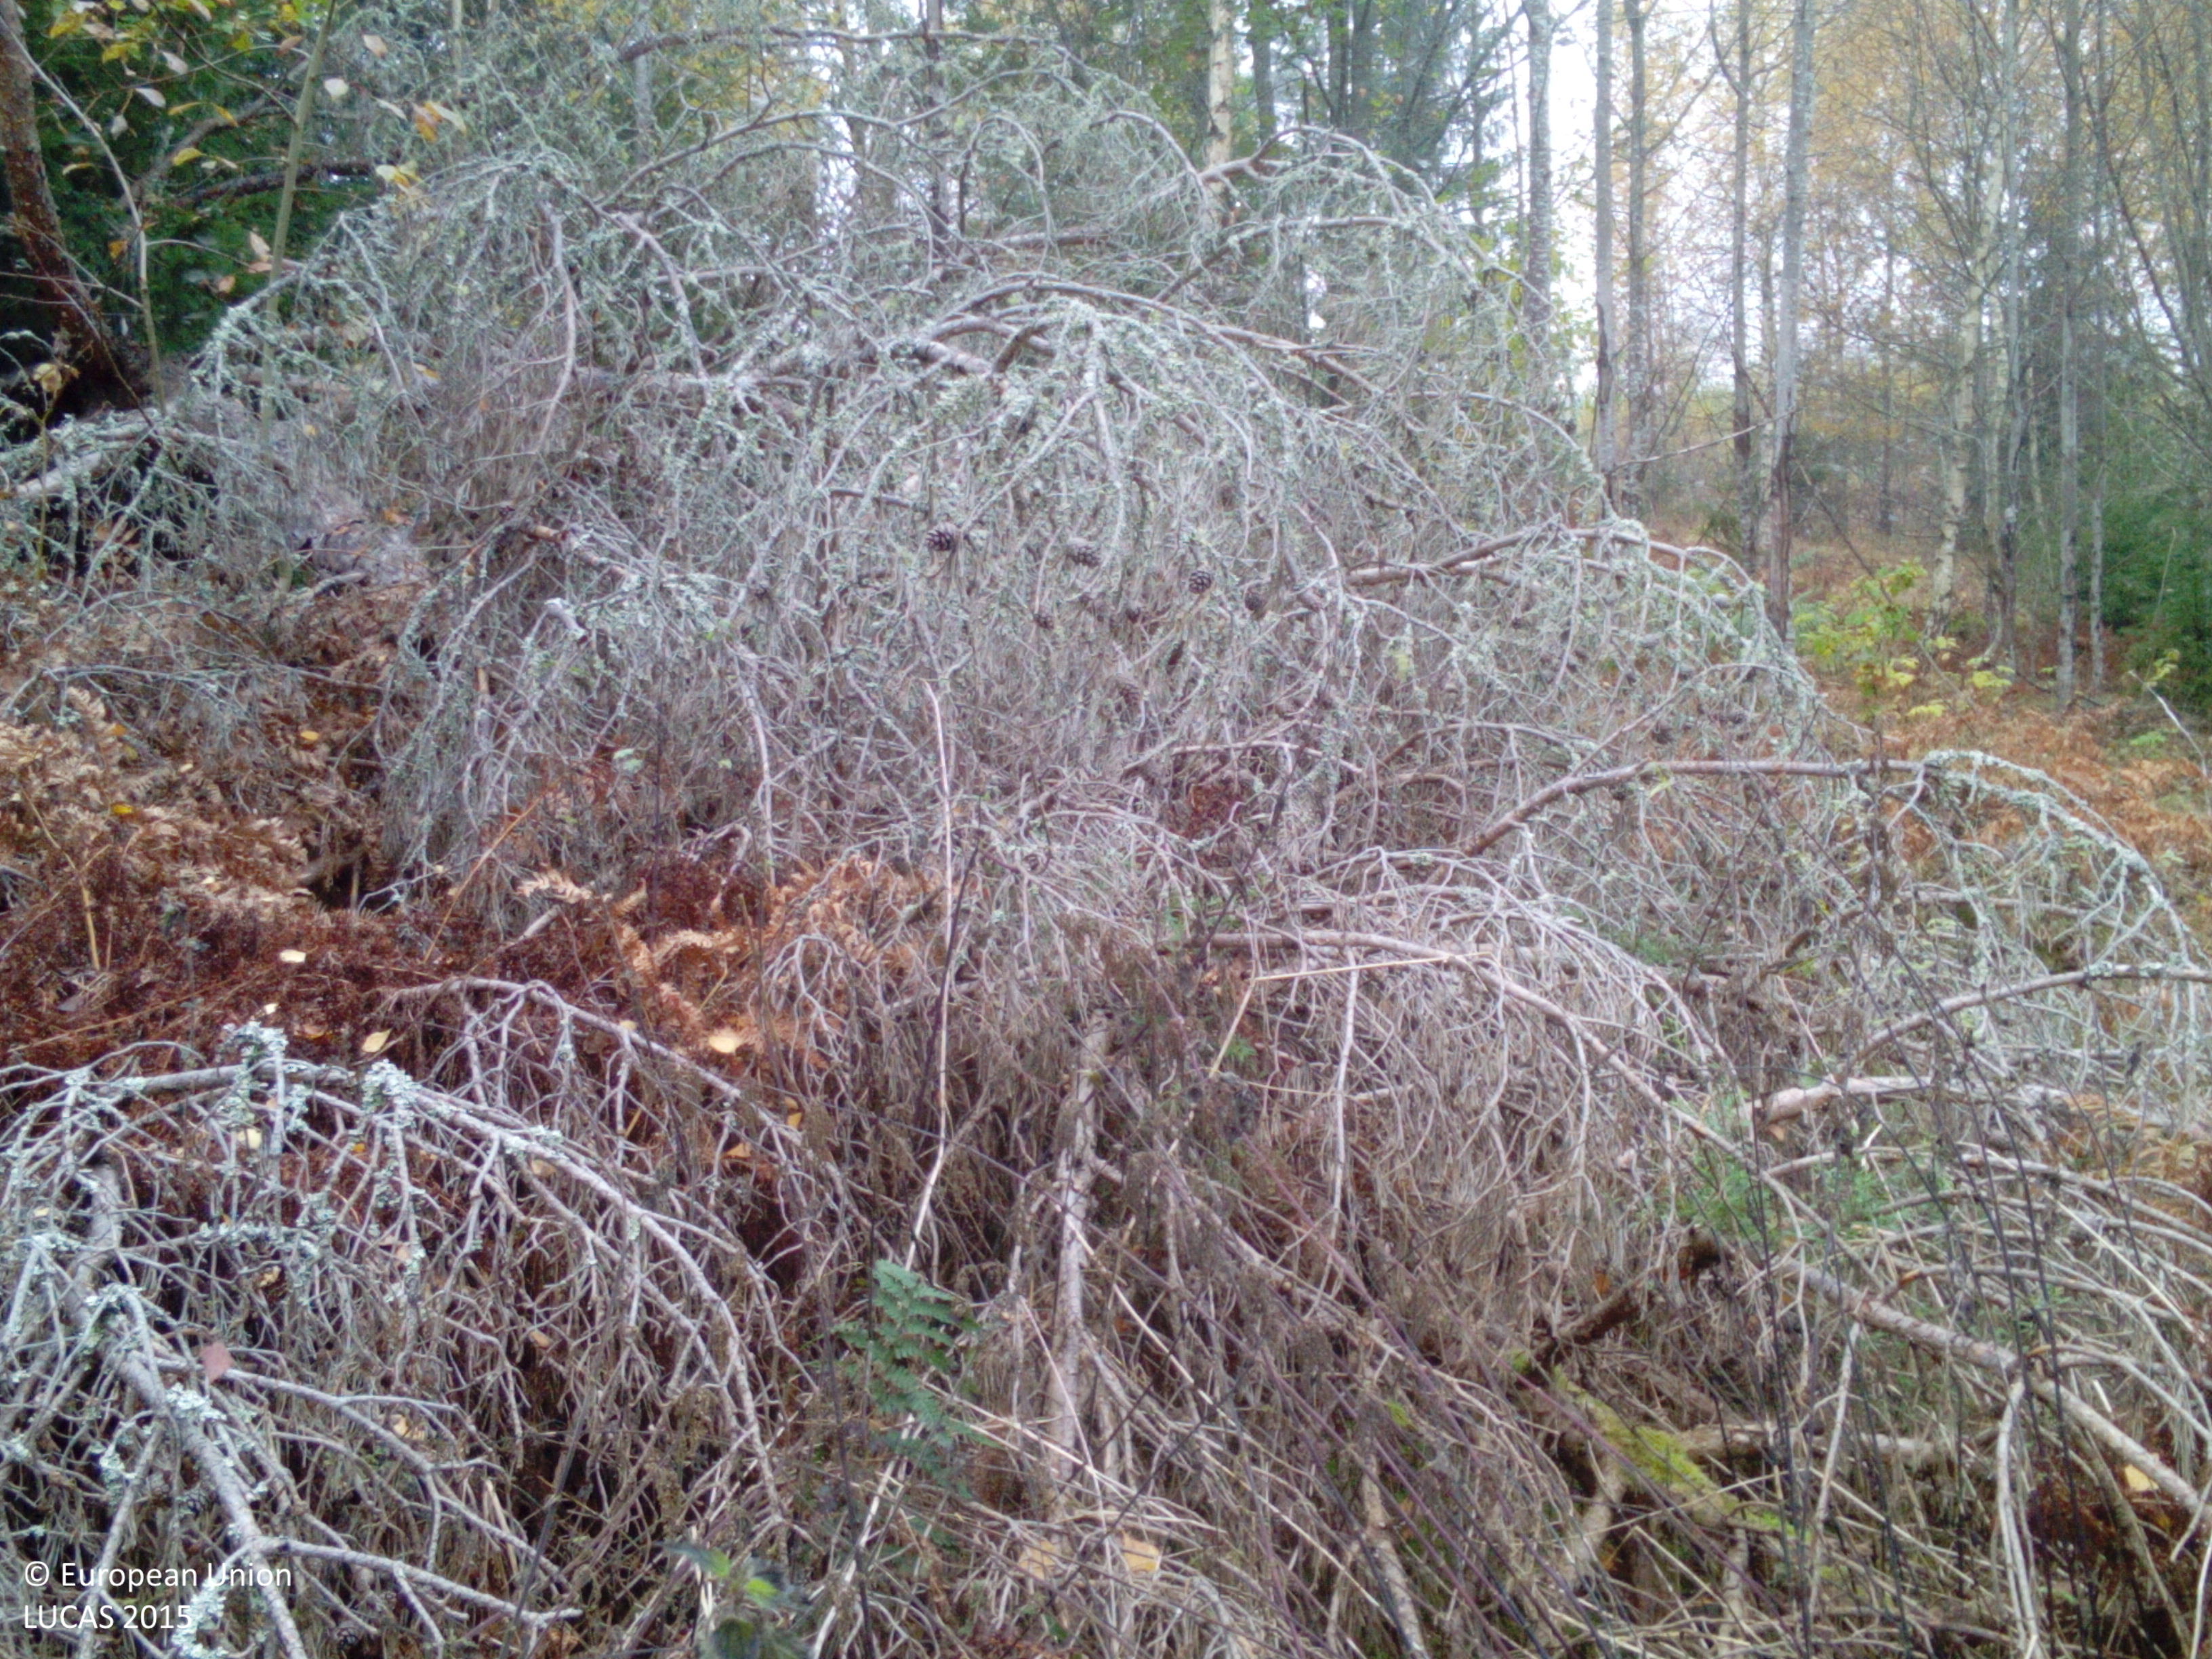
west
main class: Woodland
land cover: Spruce dominated mixed woodland
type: boreal forest
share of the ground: > 75 %
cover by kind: coniferous forest trees 60 %, broadleaved forest trees 25 %, herbaceous plants 15 %
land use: Forestry
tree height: > 5 m
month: October
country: SE
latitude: 58.9692
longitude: 16.4119
